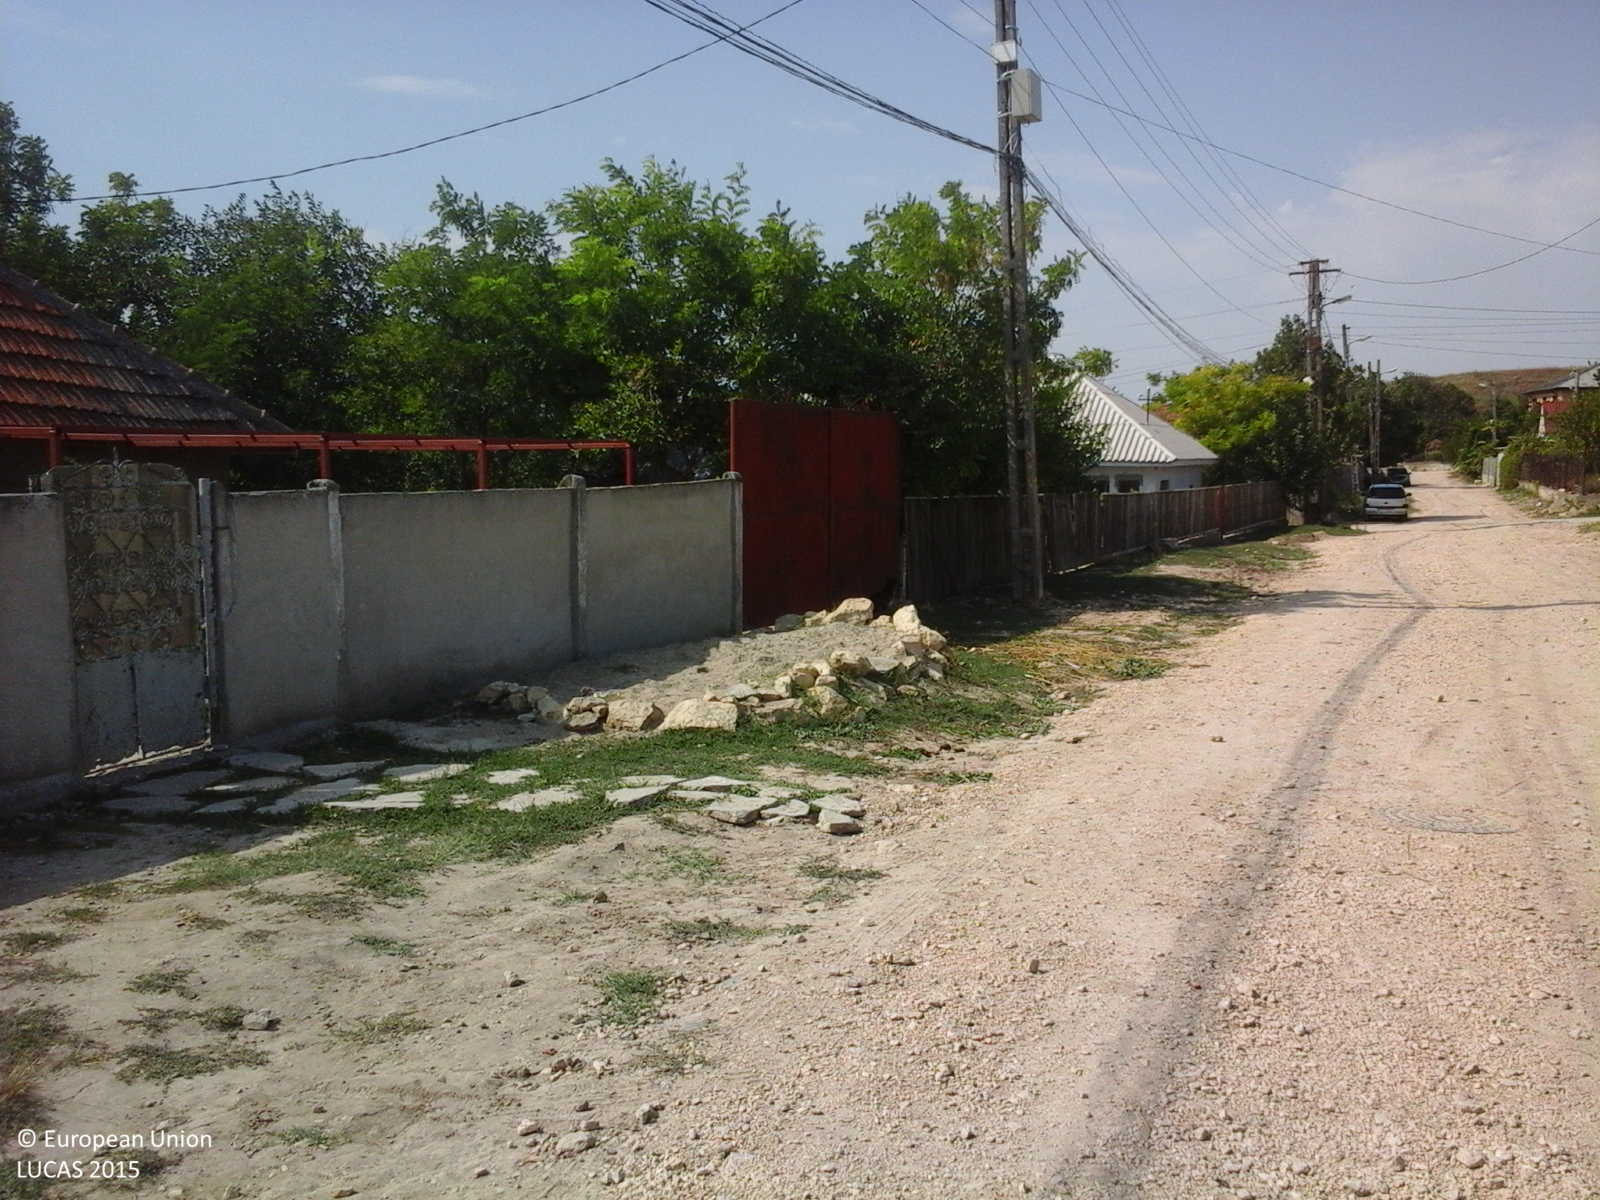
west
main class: Cropland
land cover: Other fruit trees and berries
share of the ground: 50 - 75 %
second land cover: Grassland without tree/shrub cover
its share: > 75 %
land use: Agriculture (excluding fallow land and kitchen gardens)
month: August
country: RO
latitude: 44.2018
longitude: 28.3988
